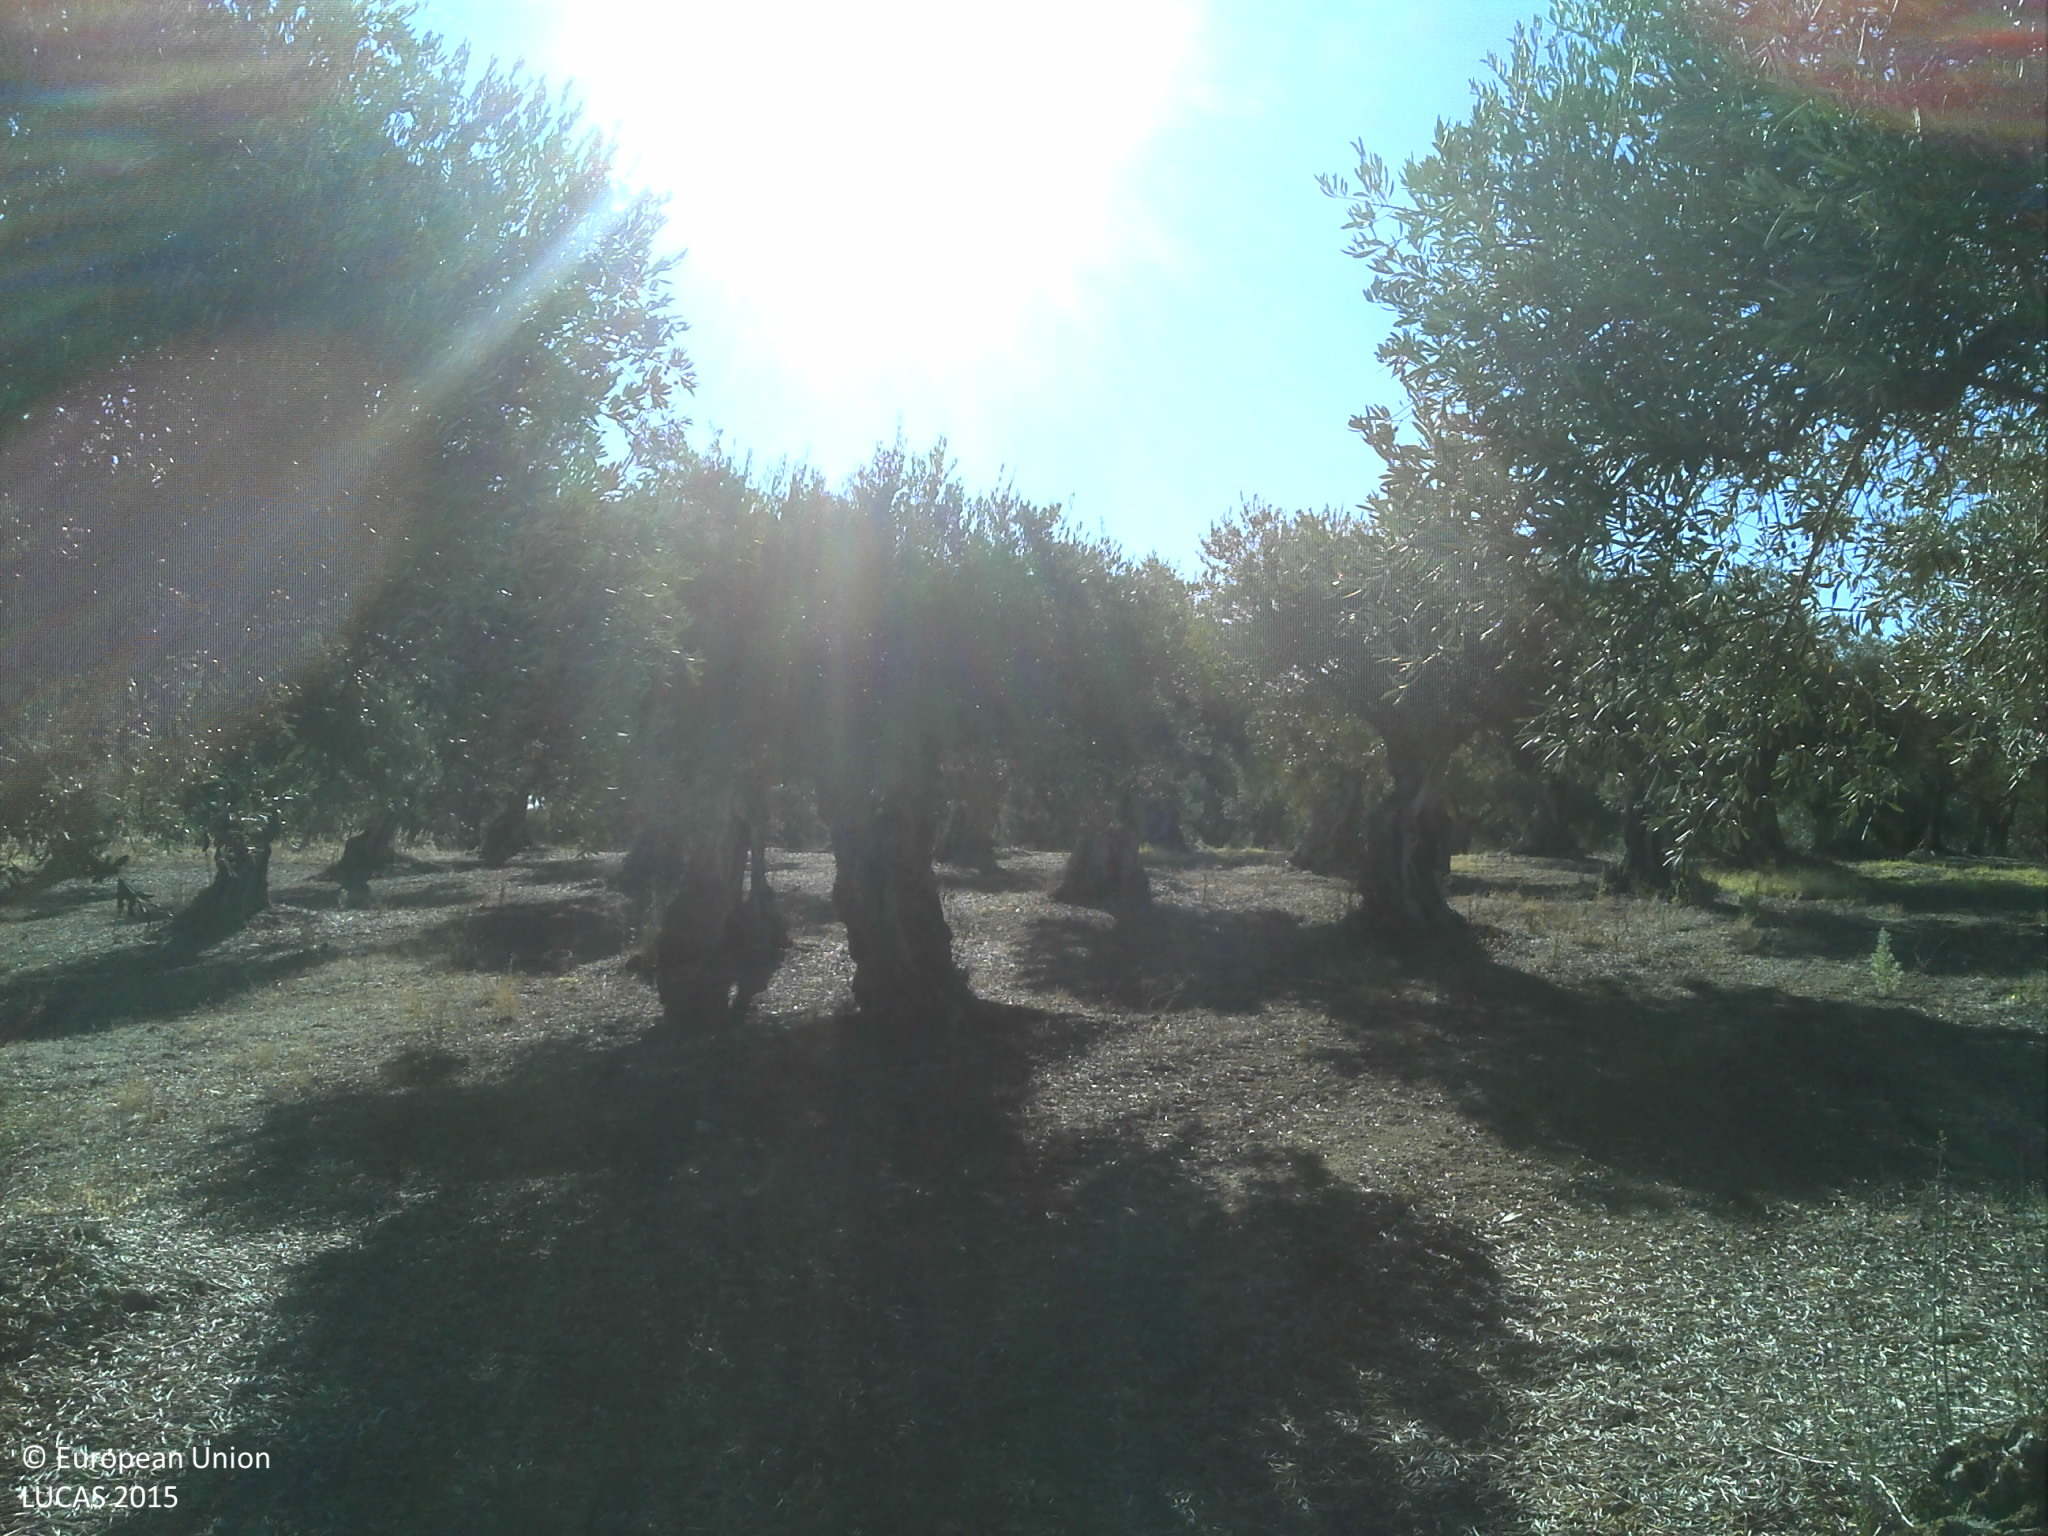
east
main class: Cropland
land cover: Olive groves
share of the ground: 25 - 50 %
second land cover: Grassland without tree/shrub cover
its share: < 10 %
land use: Agriculture (excluding fallow land and kitchen gardens)
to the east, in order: Olive groves; Grassland without tree/shrub cover; Olive groves
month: July
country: PT
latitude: 39.0262
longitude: -7.0188
